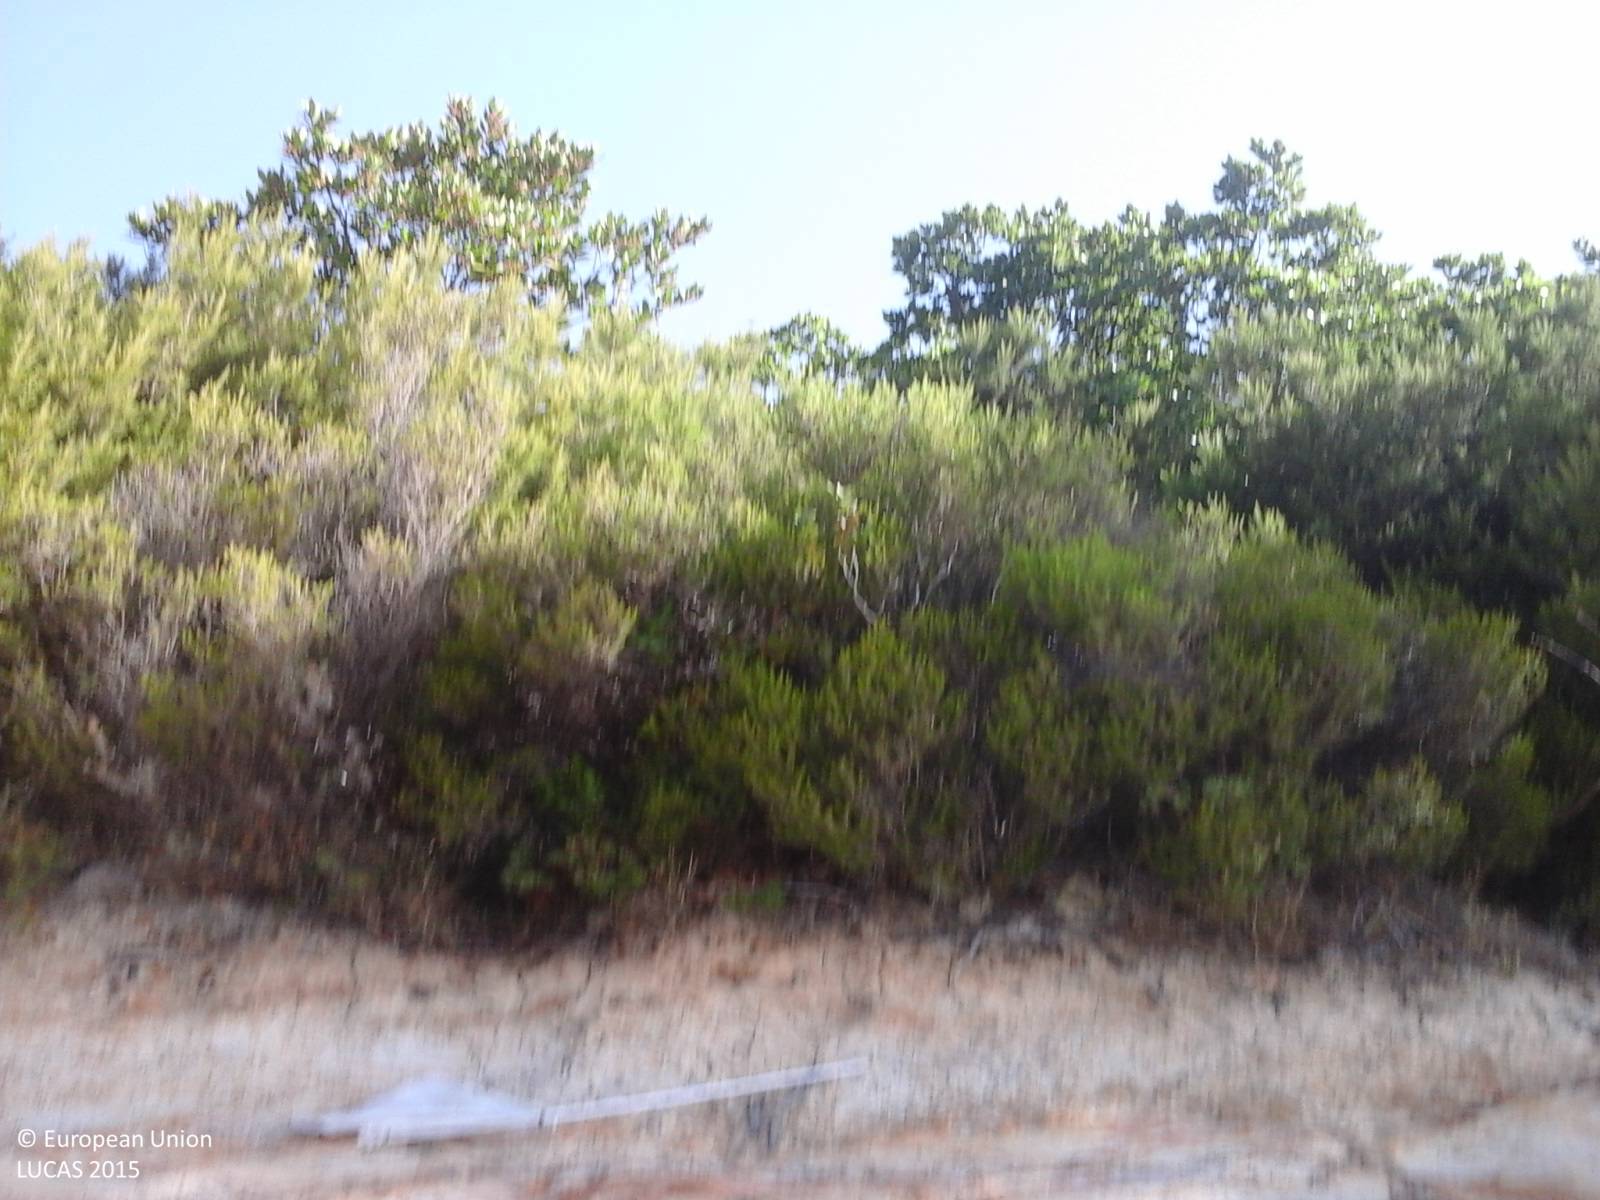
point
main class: Shrubland
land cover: Shrubland without tree cover
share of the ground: > 75 %
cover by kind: shrubs 75 %, herbaceous plants 15 %, consolidated bare surface 5 %, unconsolidated bare surface 5 %
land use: Agriculture (excluding fallow land and kitchen gardens)
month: September
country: IT
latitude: 39.8849
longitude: 9.3372
